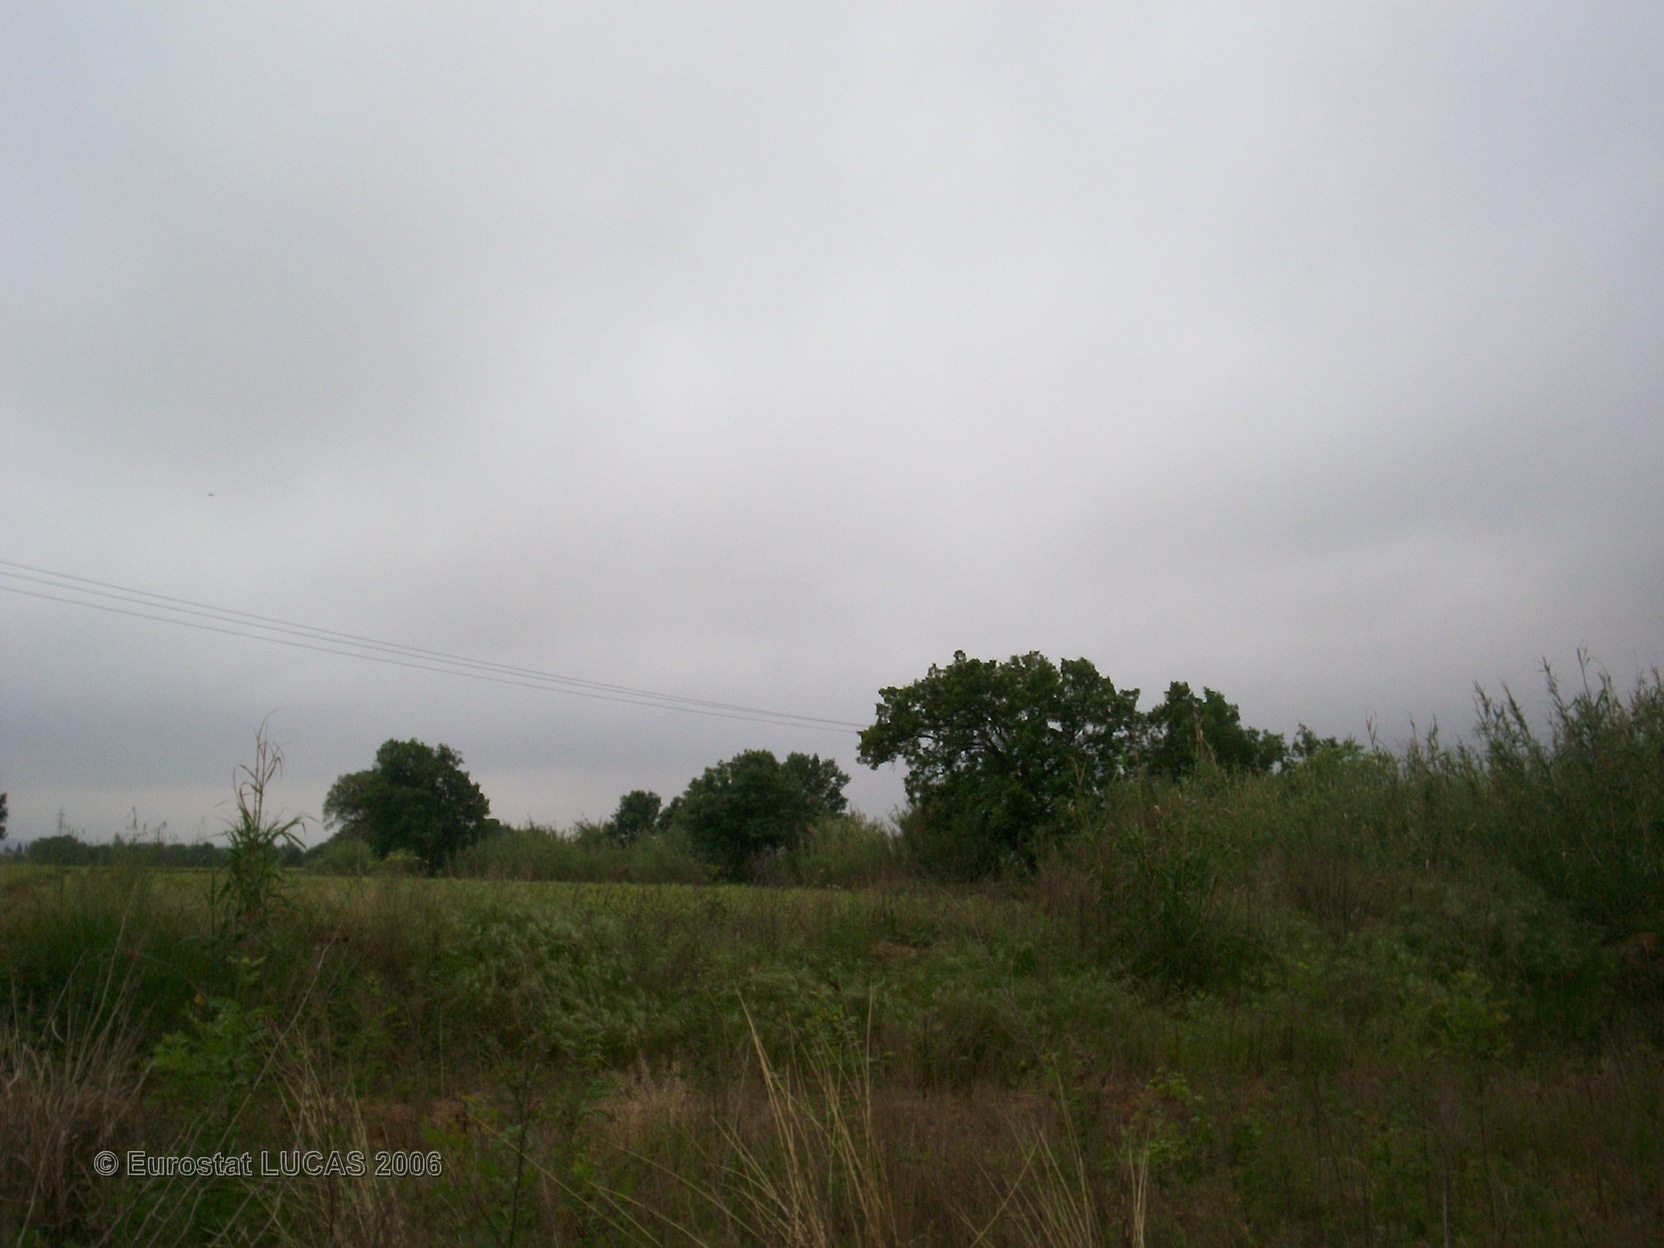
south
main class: Grassland
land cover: Grassland without tree/shrub cover
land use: Agriculture (excluding fallow land and kitchen gardens)
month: May
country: FR
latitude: 43.6565
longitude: 3.4739
